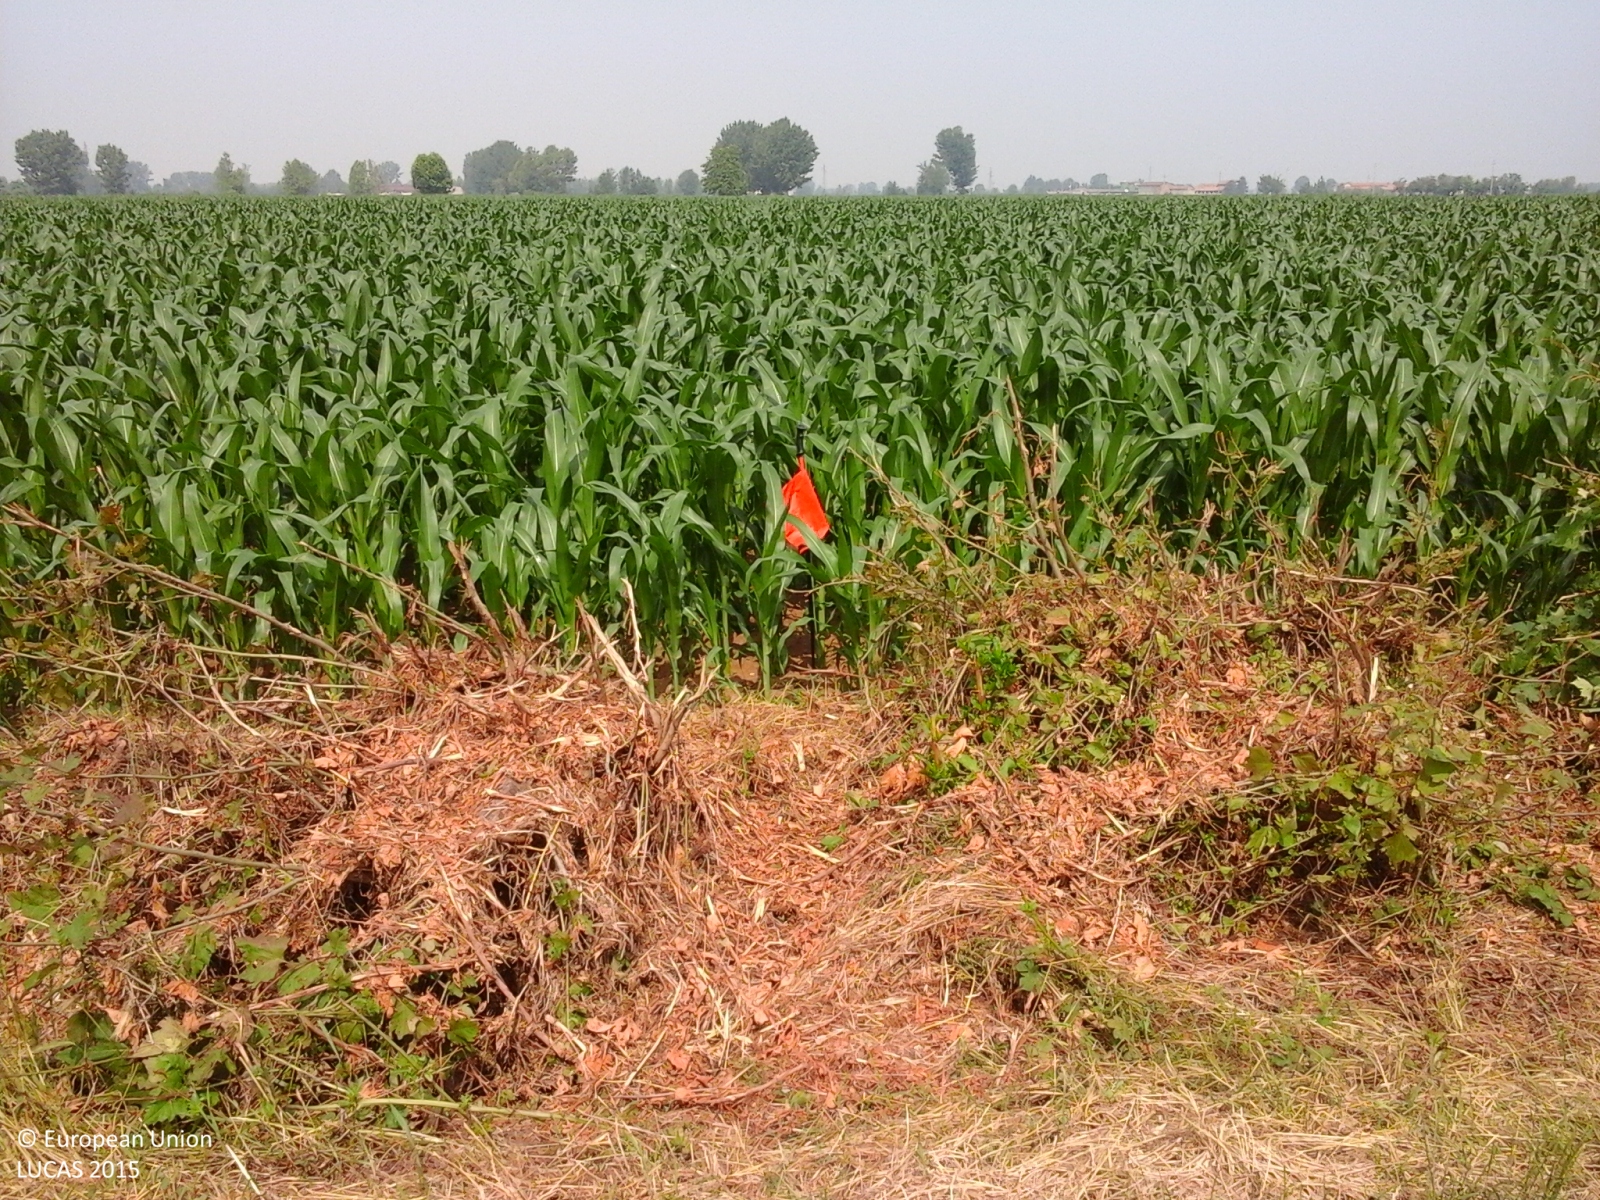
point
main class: Cropland
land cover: Maize
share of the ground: > 75 %
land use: Agriculture (excluding fallow land and kitchen gardens)
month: June
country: IT
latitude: 45.3782
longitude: 10.0128
